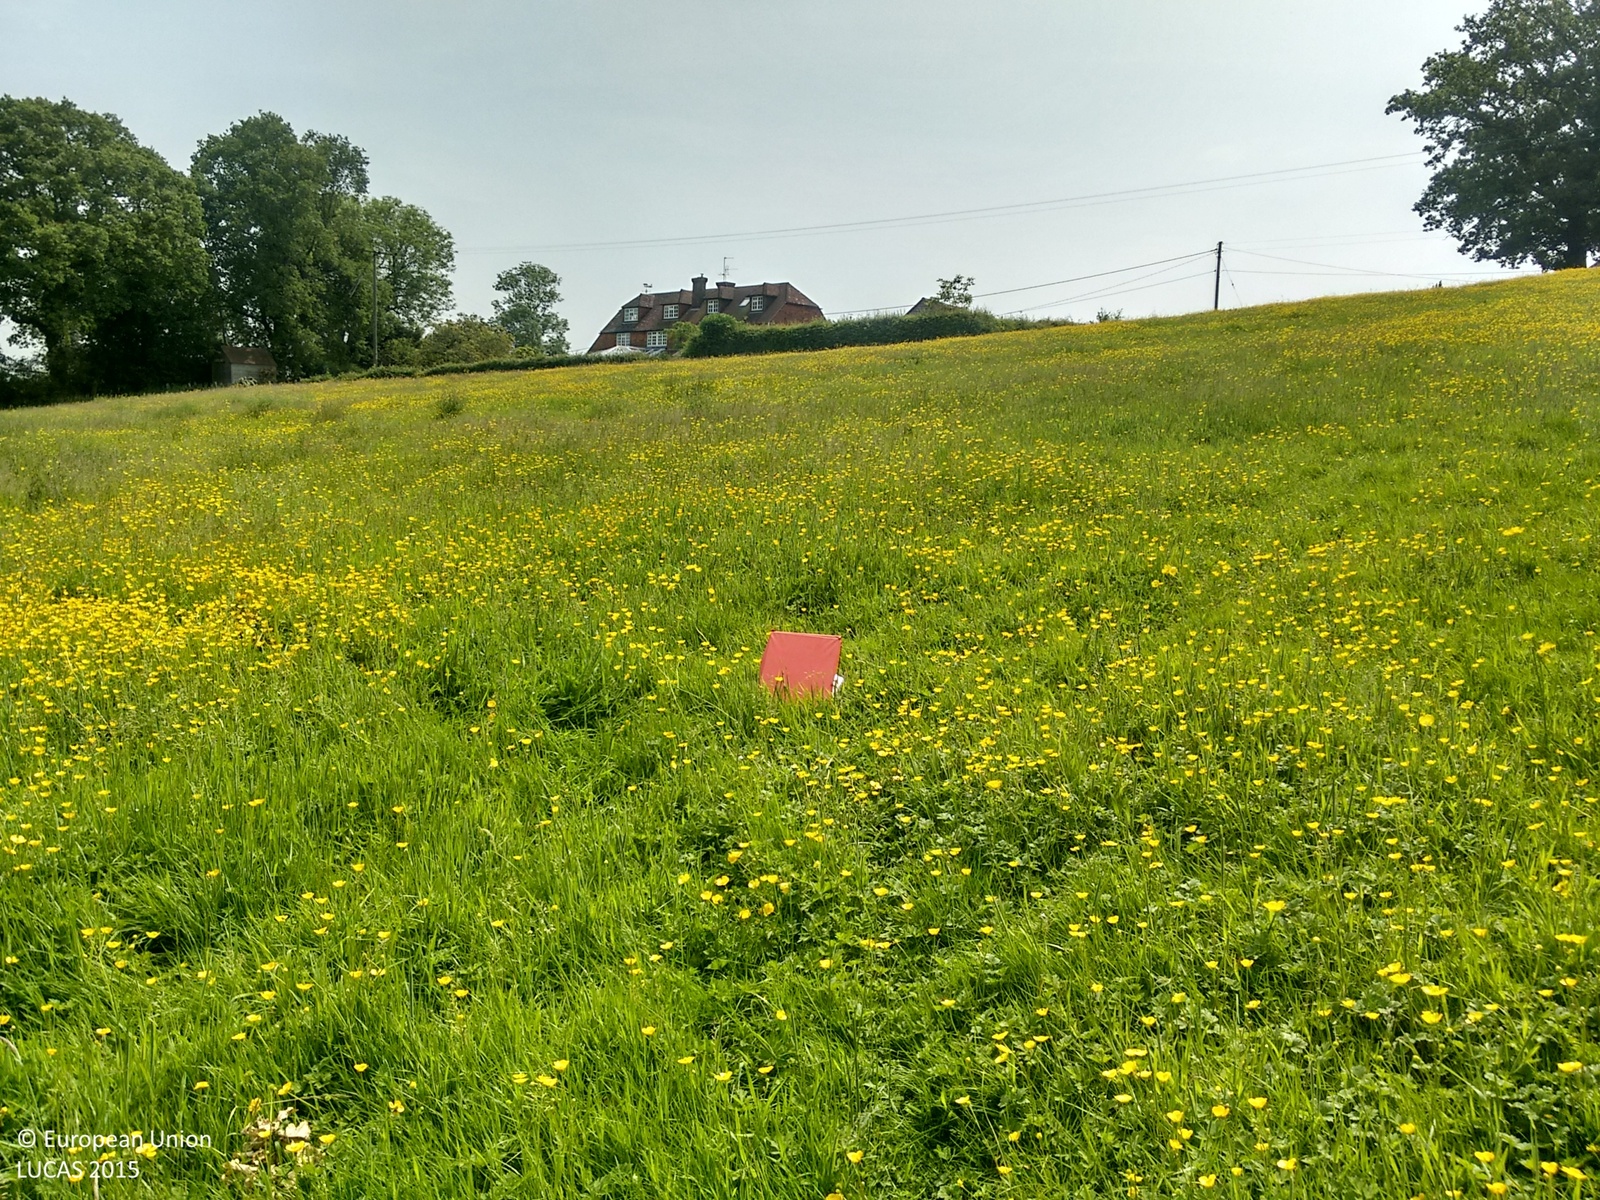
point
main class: Grassland
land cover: Grassland without tree/shrub cover
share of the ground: > 75 %
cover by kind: herbaceous plants 100 %
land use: Agriculture (excluding fallow land and kitchen gardens)
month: June
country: GB
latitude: 51.0365
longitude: 0.2869
